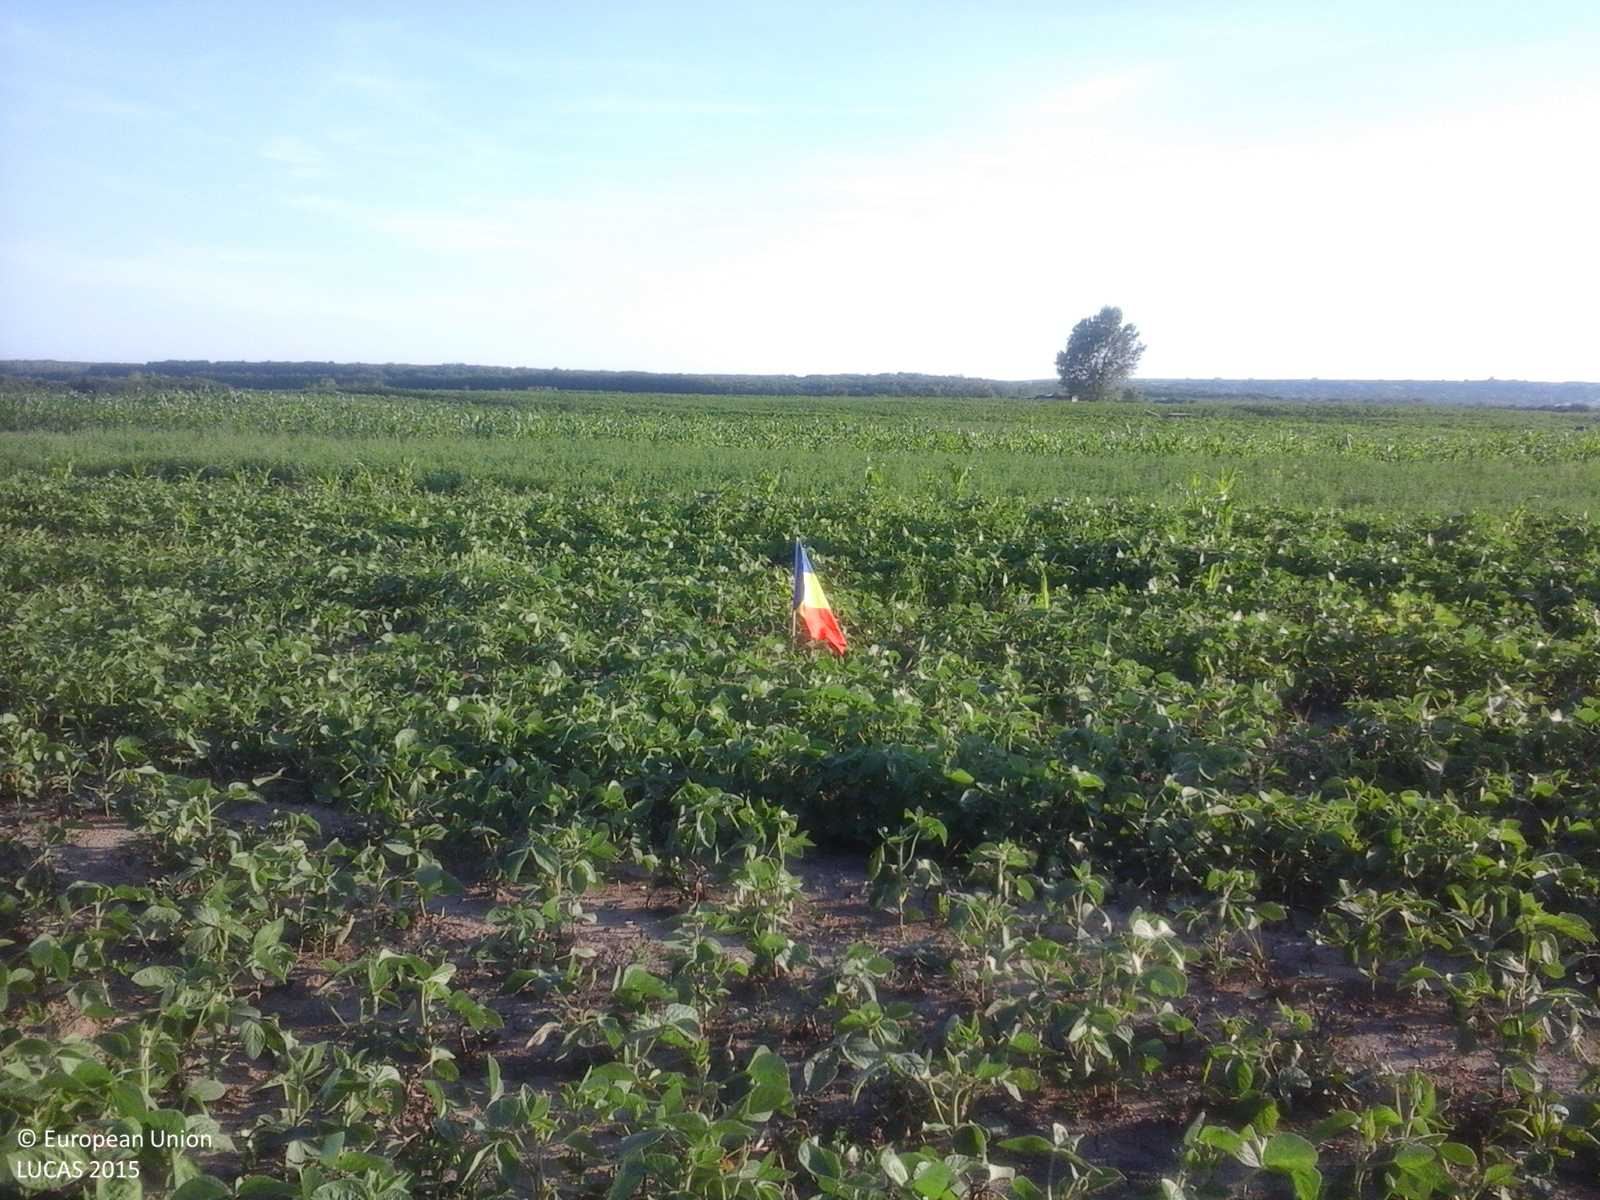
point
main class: Cropland
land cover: Soya
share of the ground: 50 - 75 %
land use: Agriculture (excluding fallow land and kitchen gardens)
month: June
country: RO
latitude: 47.7468
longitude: 27.2787
